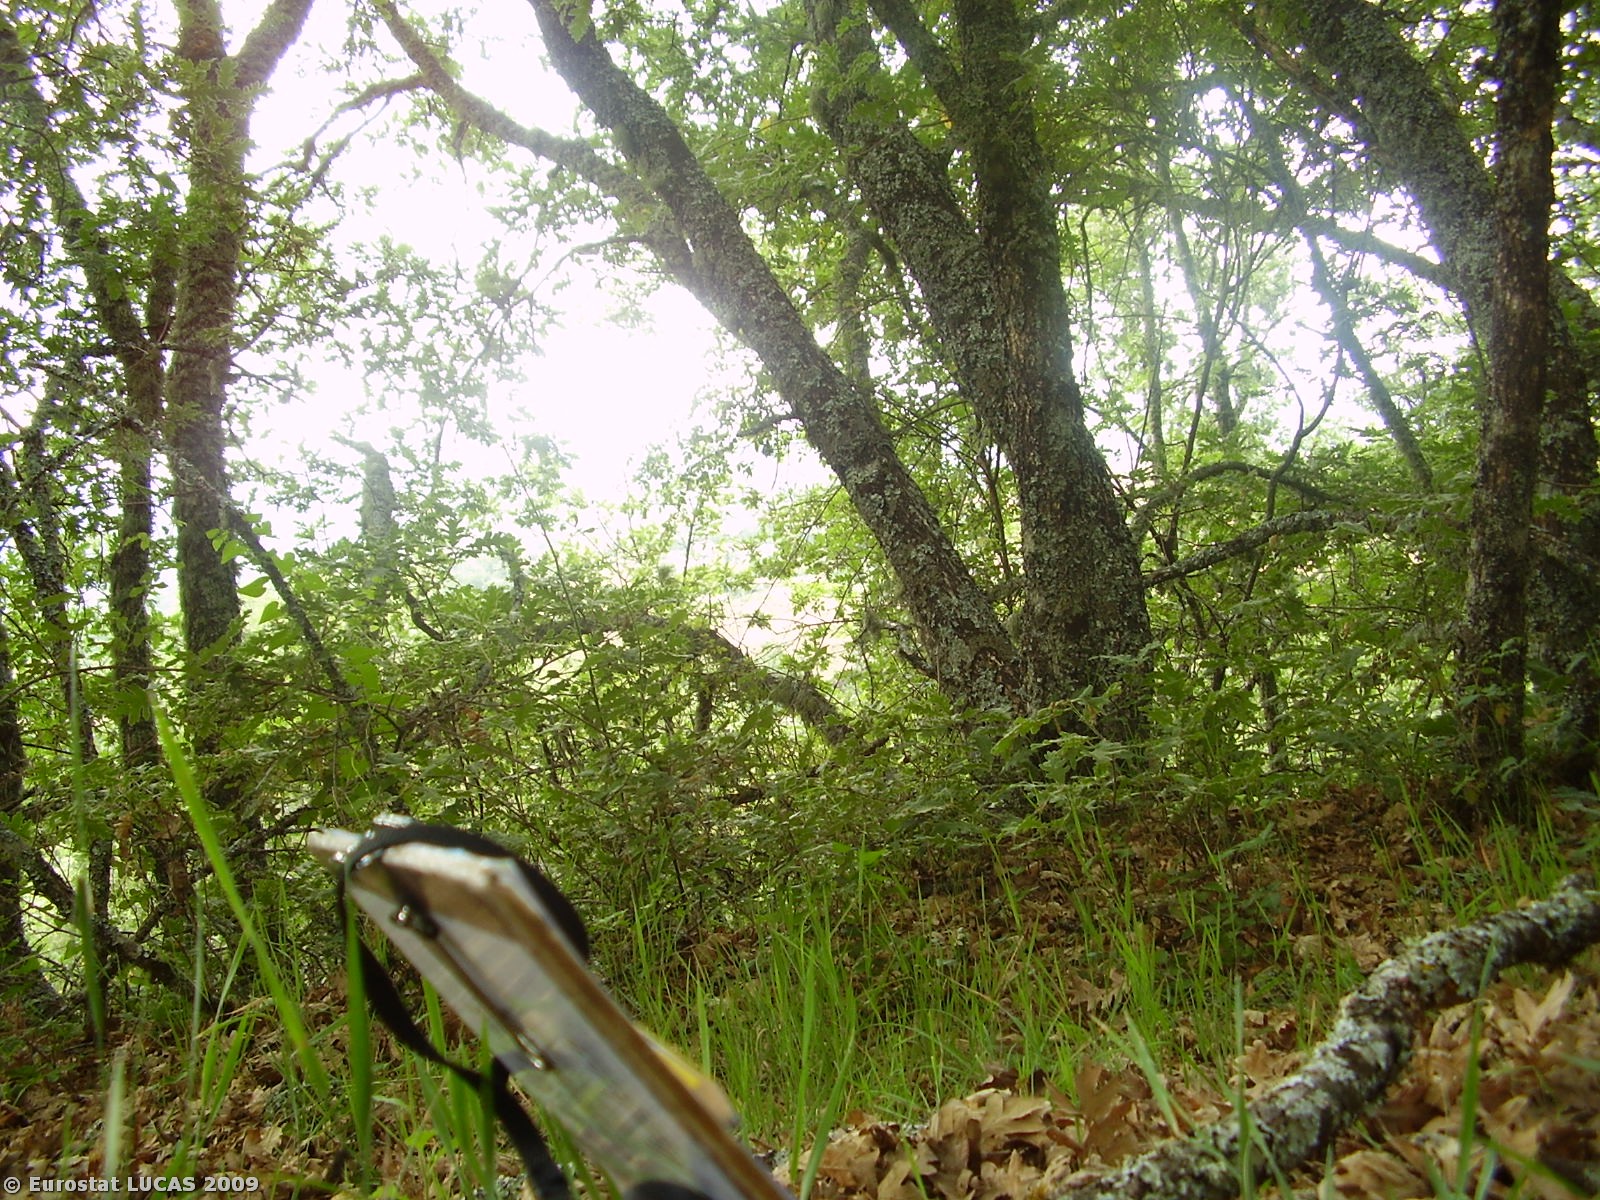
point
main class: Woodland
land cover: Broadleaved woodland
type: acidophilous oak and oak-birch forest
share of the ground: > 75 %
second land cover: Spontaneously vegetated surfaces
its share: 25 - 50 %
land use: Forestry
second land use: Nature reserves
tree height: > 5 m
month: June
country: PT
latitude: 41.7122
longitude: -6.8317
